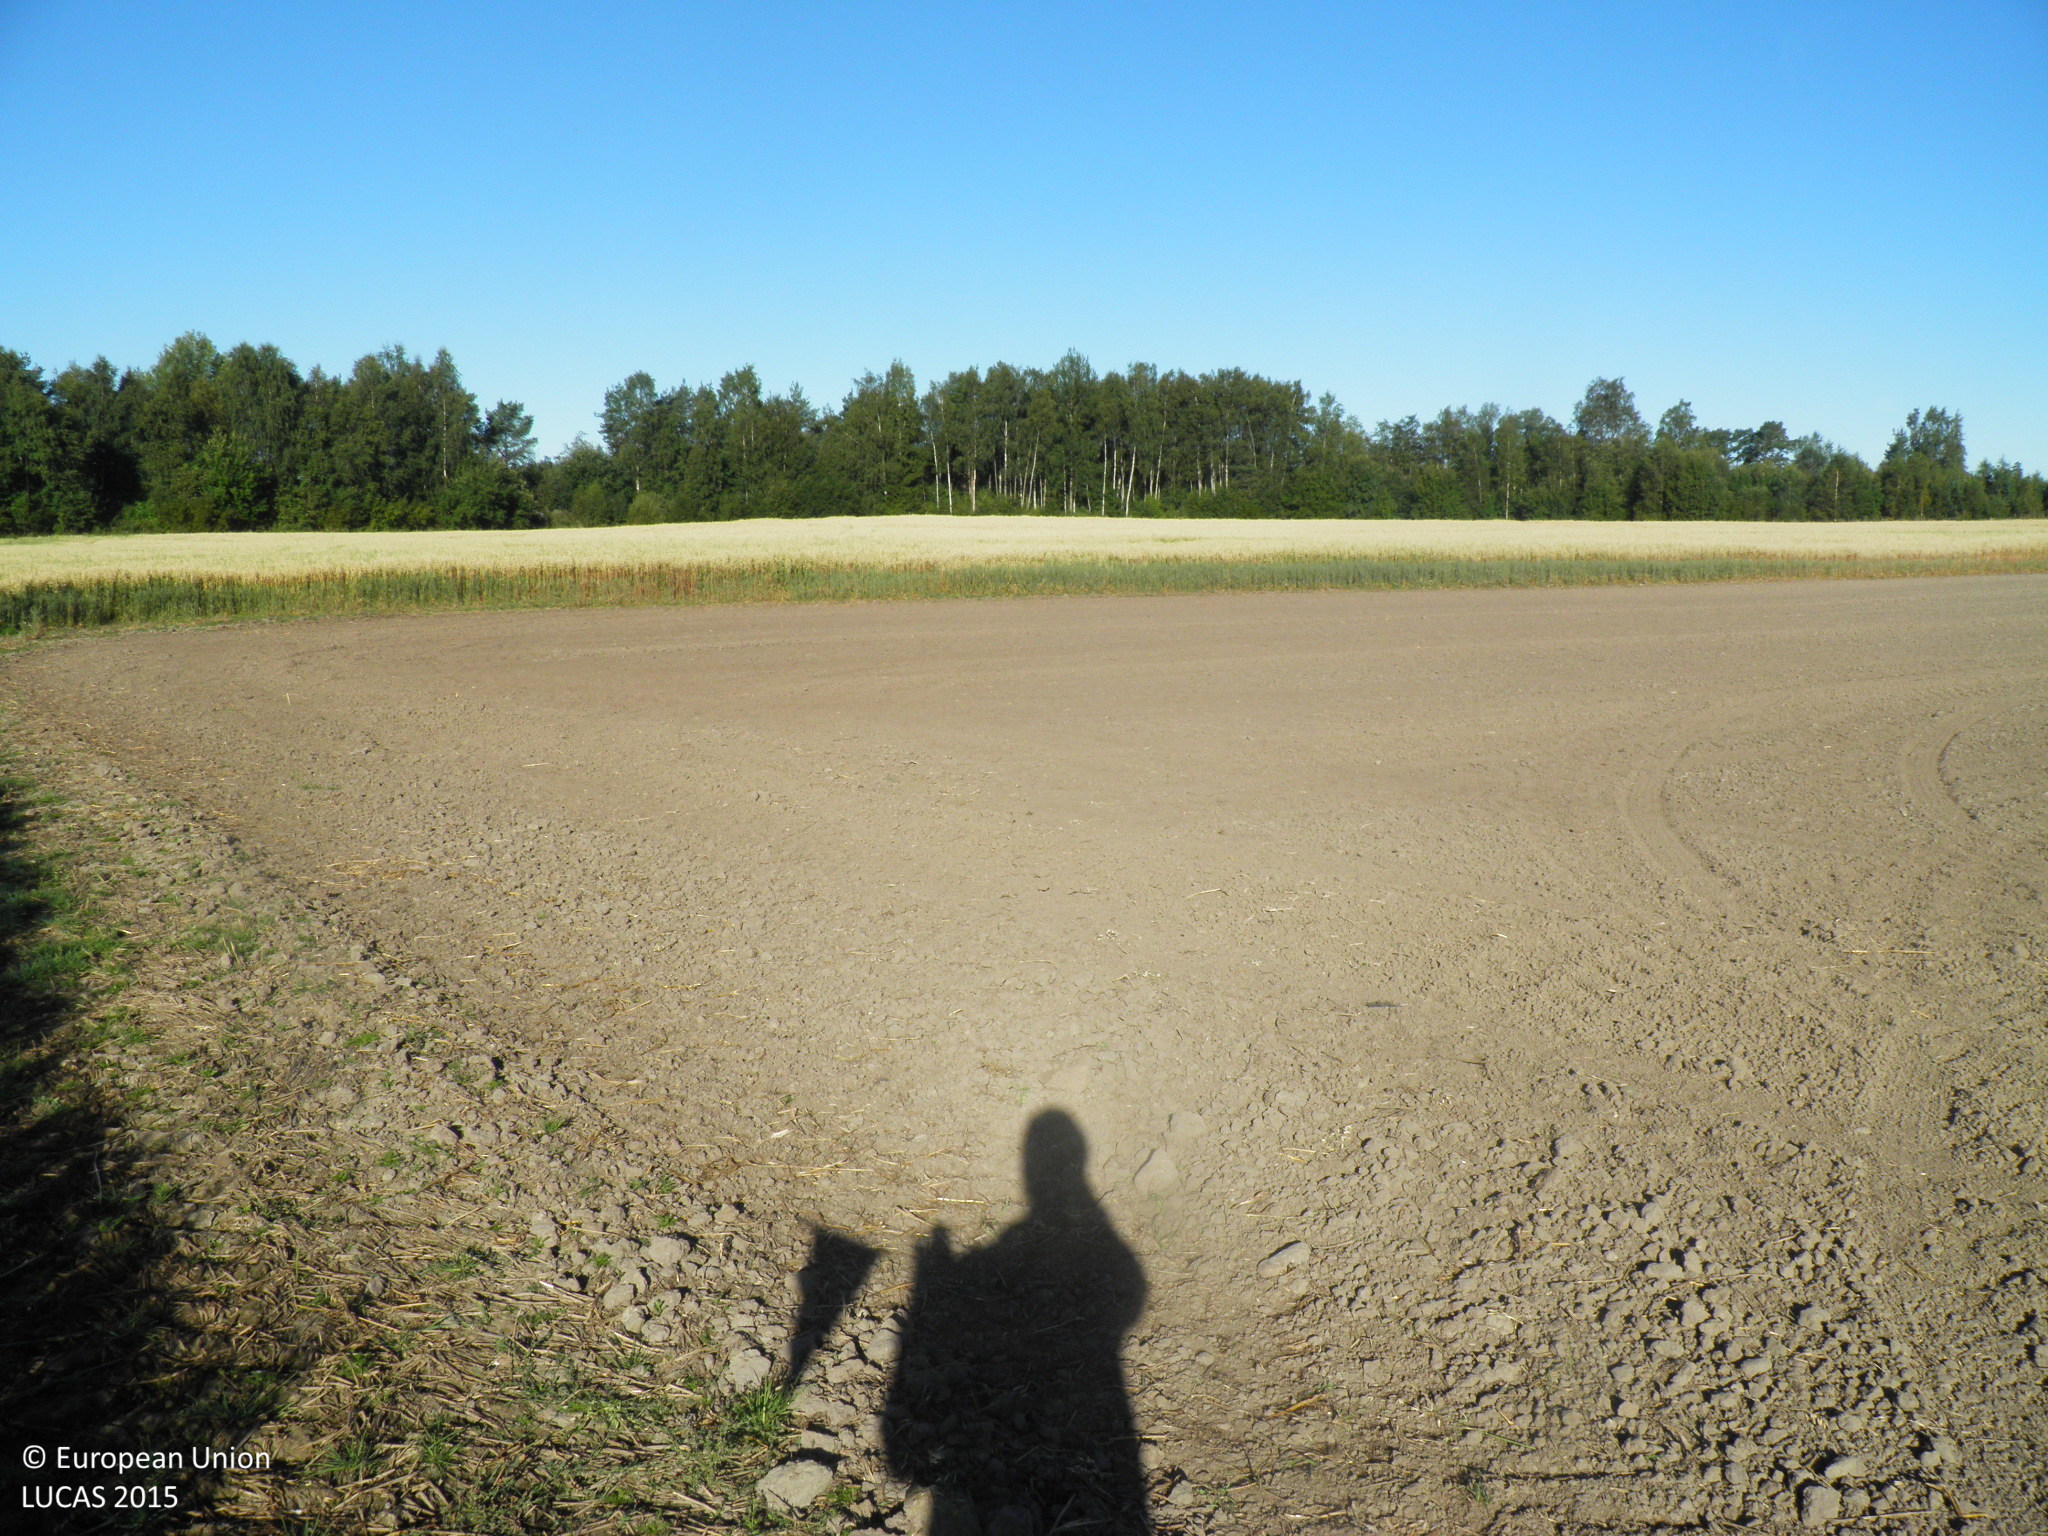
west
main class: Cropland
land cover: Oats
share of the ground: > 75 %
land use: Agriculture (excluding fallow land and kitchen gardens)
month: August
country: FI
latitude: 60.8403
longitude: 21.7034
